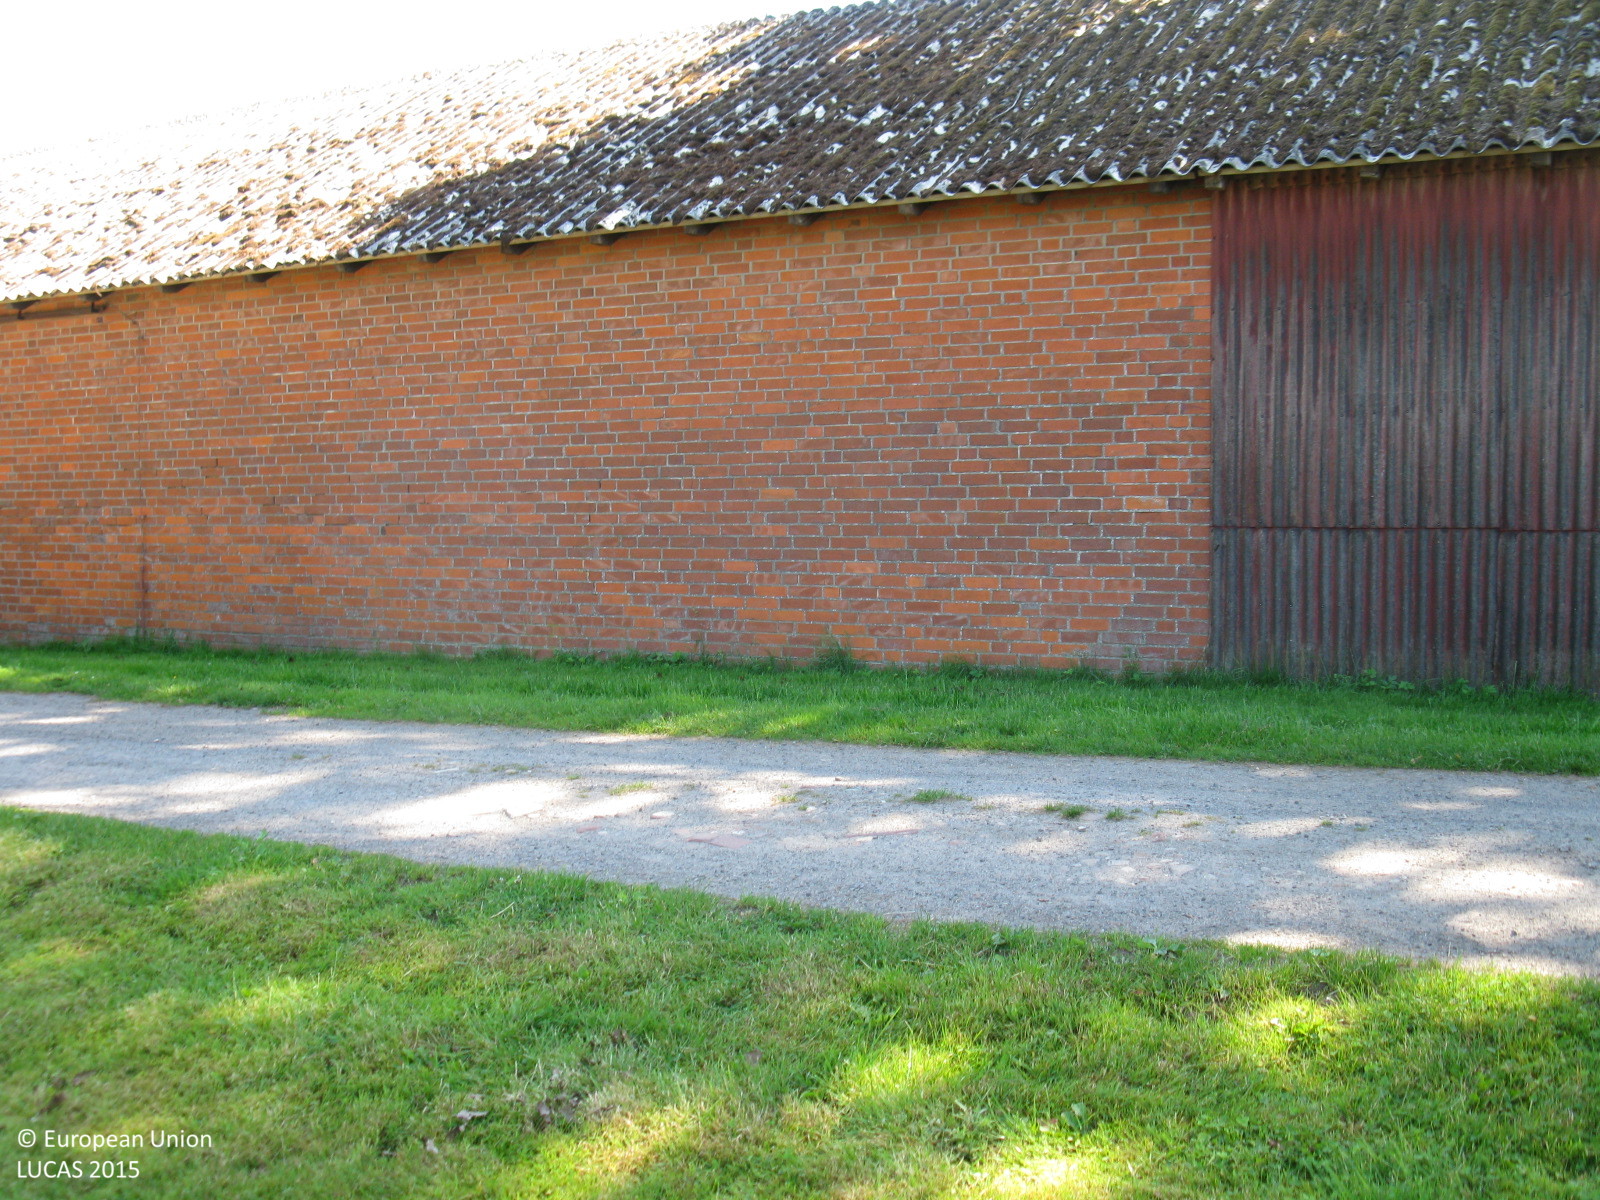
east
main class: Grassland
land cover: Grassland without tree/shrub cover
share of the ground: > 75 %
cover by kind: herbaceous plants 100 %
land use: Agriculture (excluding fallow land and kitchen gardens)
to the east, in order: Grassland without tree/shrub cover; Fences; Tracks; Fences; Grassland without tree/shrub cover; Lines of trees; Fences; Broadleaved woodland; Grassland without tree/shrub cover; Artificial constructions in urban areas; Barley
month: June
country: DE
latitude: 52.8717
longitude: 8.5297
